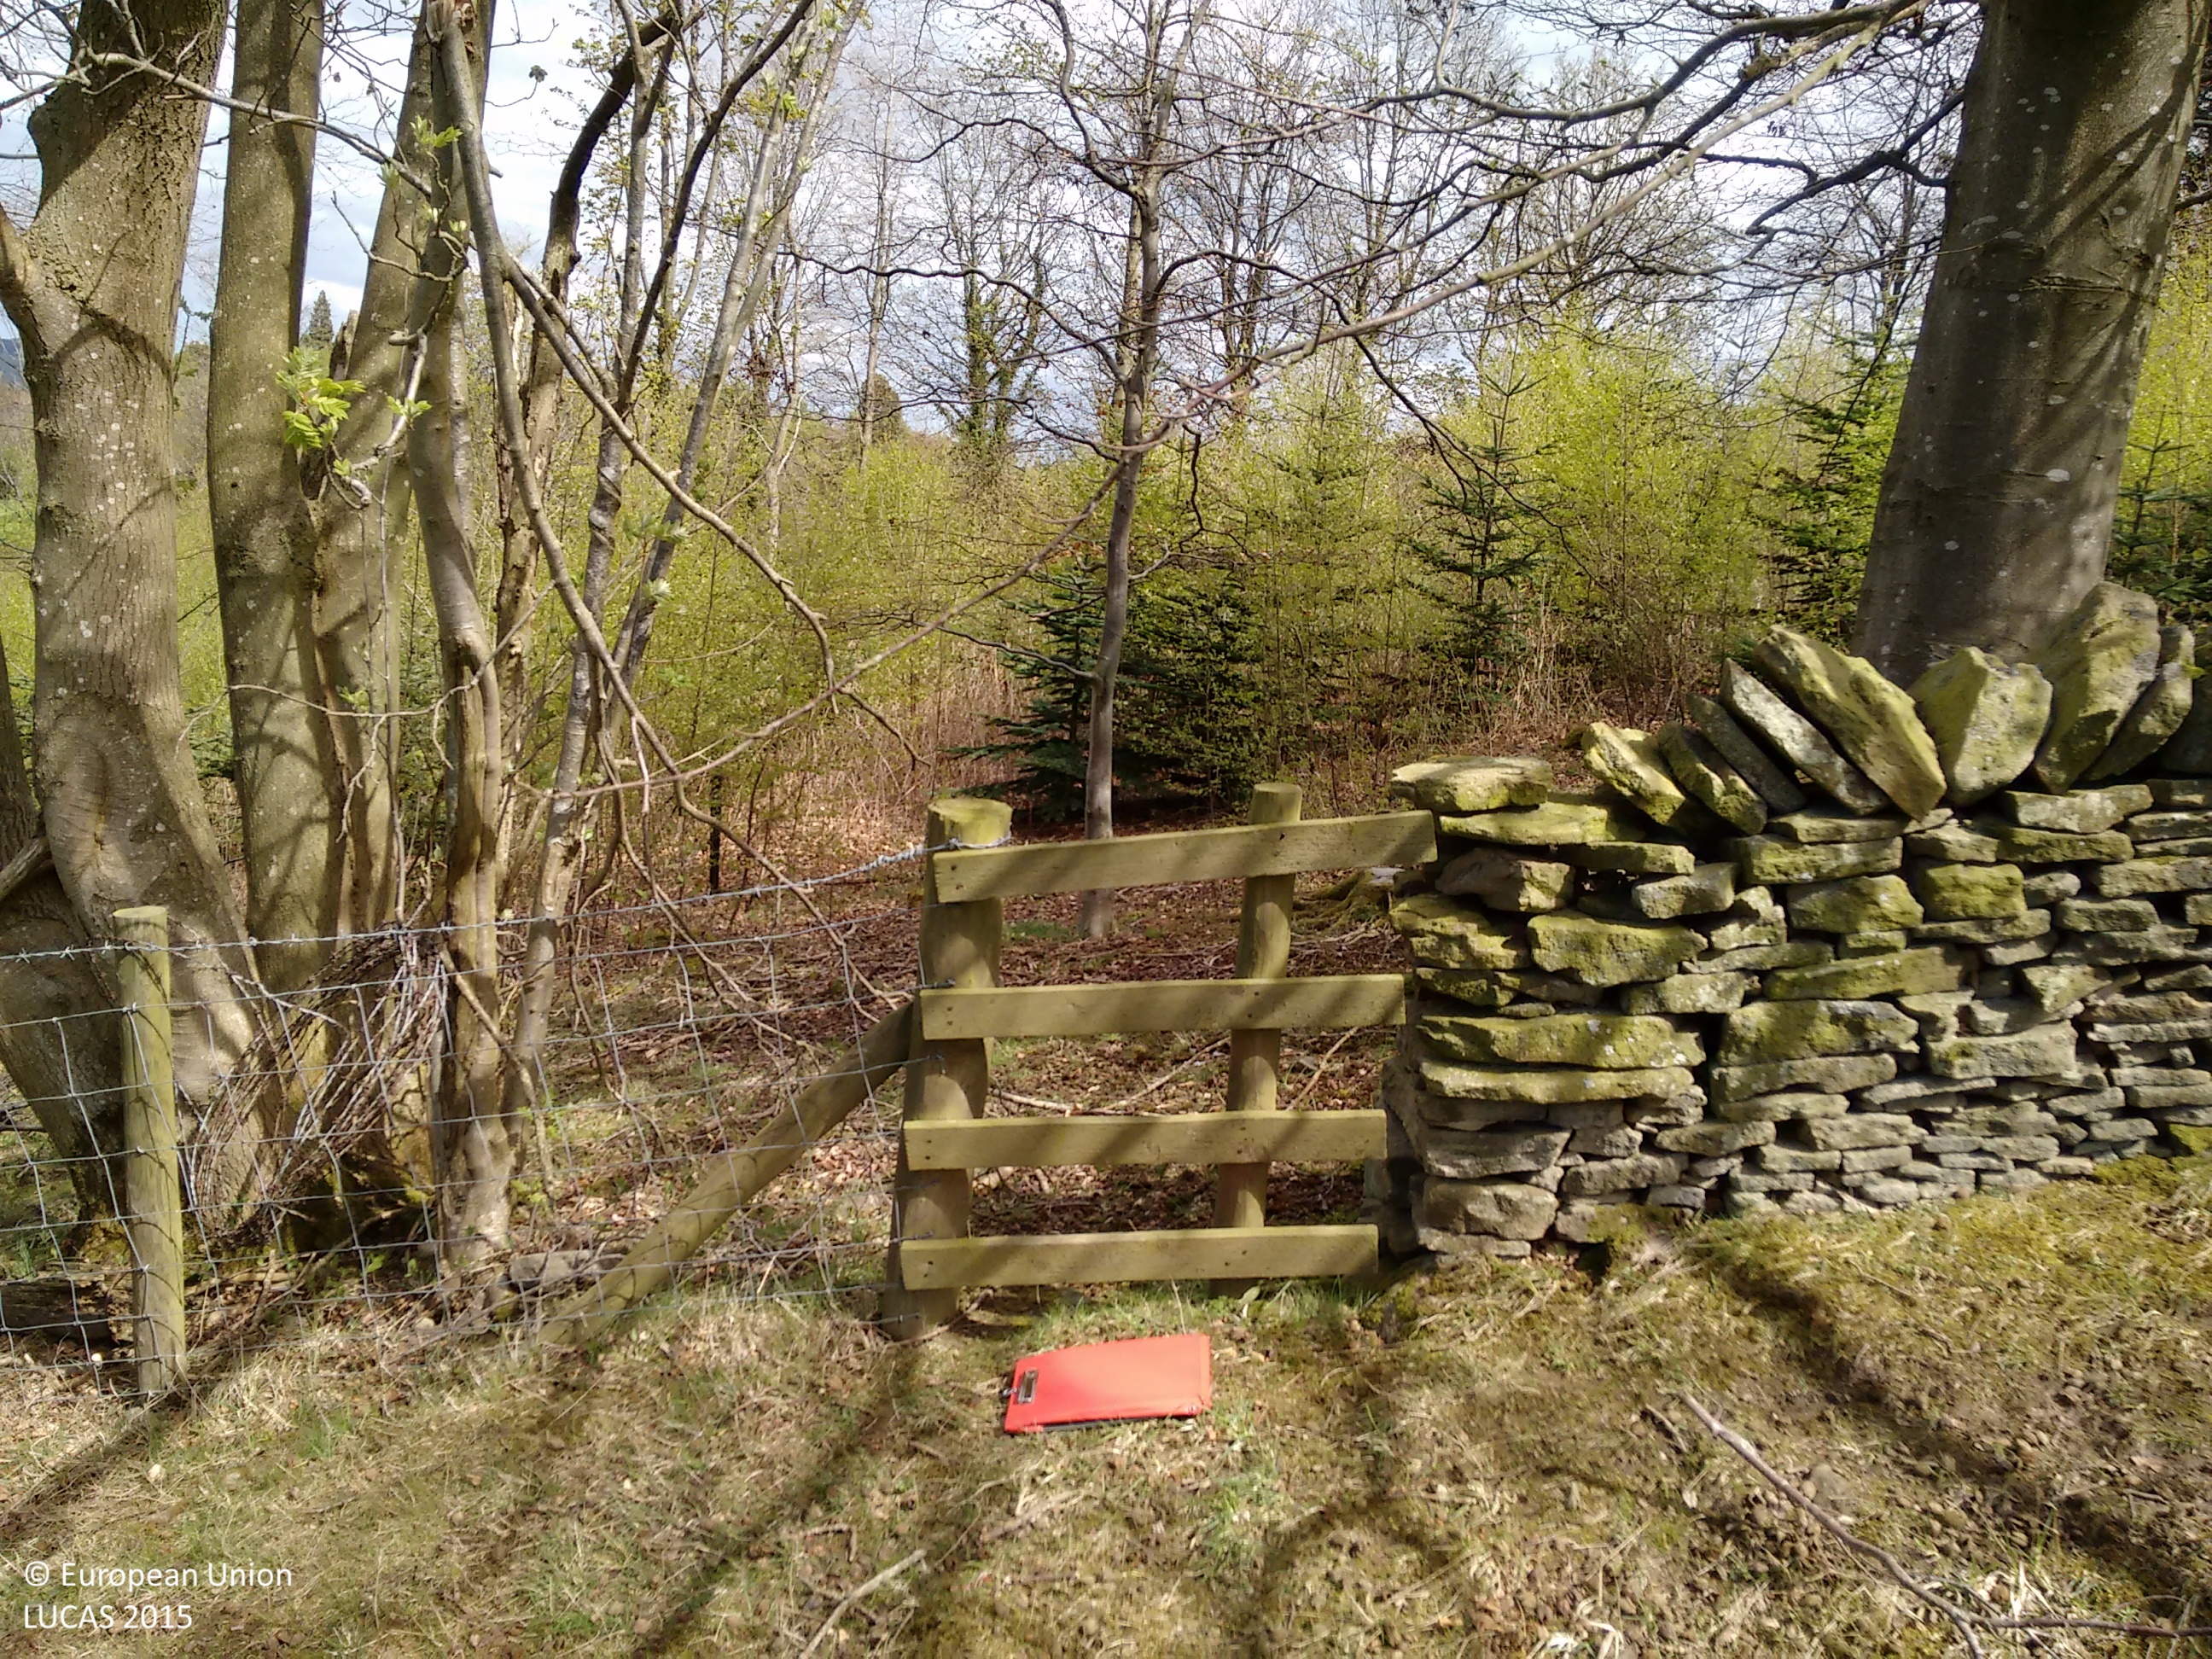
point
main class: Woodland
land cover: Broadleaved woodland
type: acidophilous oak and oak-birch forest
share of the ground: > 75 %
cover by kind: broadleaved forest trees 100 %
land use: Forestry
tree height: > 5 m
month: May
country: GB
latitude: 54.9577
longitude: -2.0965
